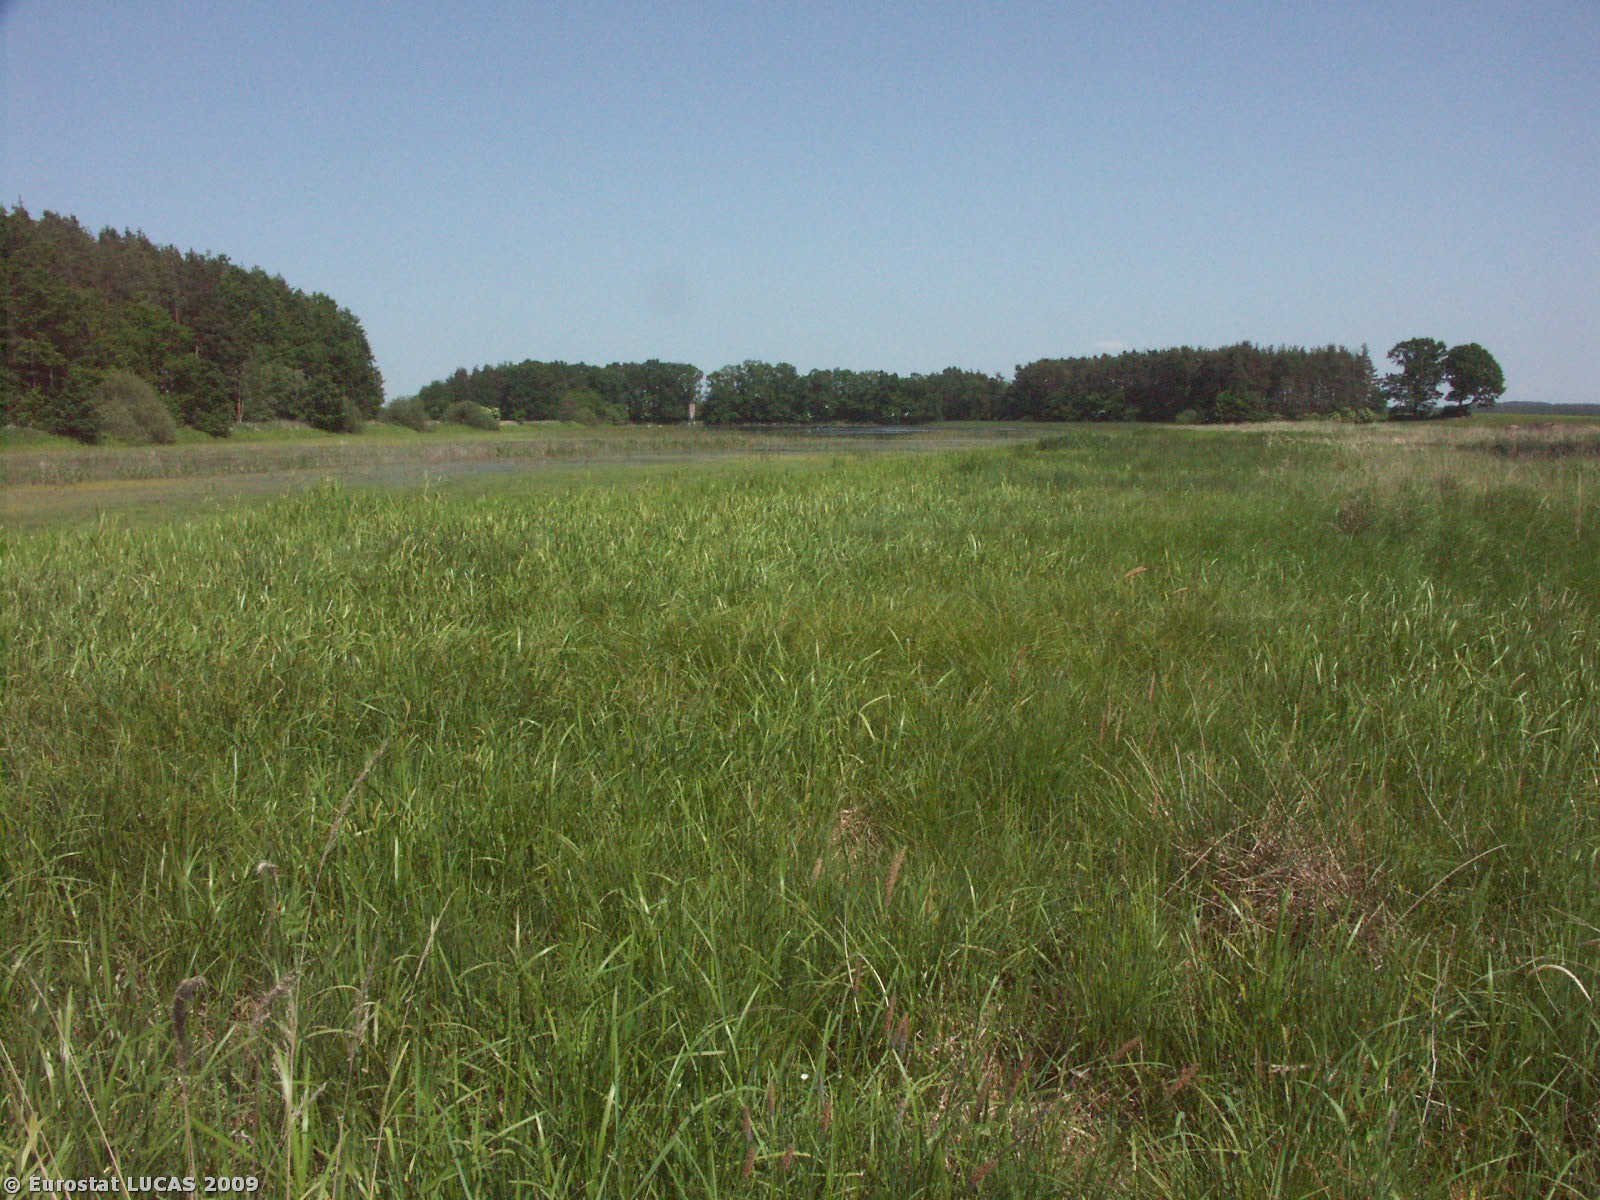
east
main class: Grassland
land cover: Grassland without tree/shrub cover
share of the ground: > 75 %
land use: Unused
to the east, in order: Grassland without tree/shrub cover; Inland marshes; Inland water bodies
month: May
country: CZ
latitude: 49.0450
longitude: 14.6394
